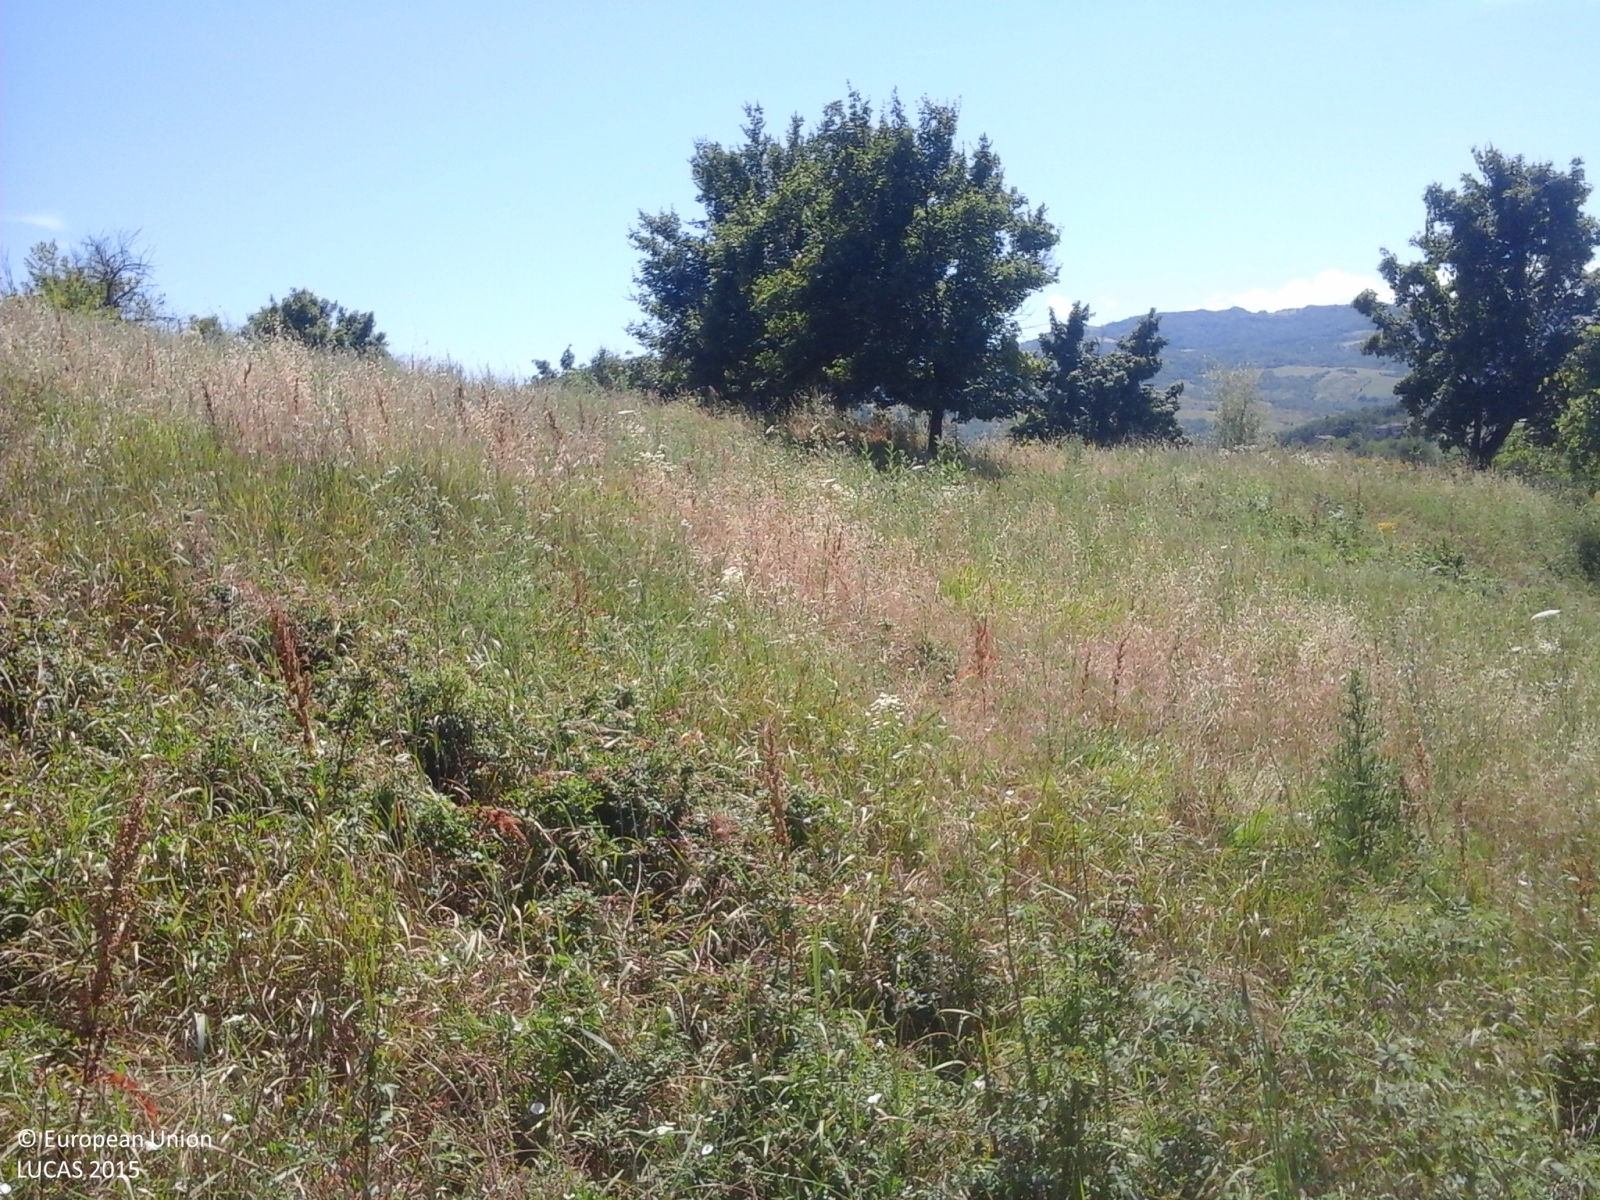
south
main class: Grassland
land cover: Grassland with sparse tree/shrub cover
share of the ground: > 75 %
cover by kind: herbaceous plants 90 %, broadleaved forest trees 5 %, shrubs 5 %
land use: Semi-natural and natural areas not in use
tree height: > 5 m
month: June
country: IT
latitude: 44.4929
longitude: 10.6399
